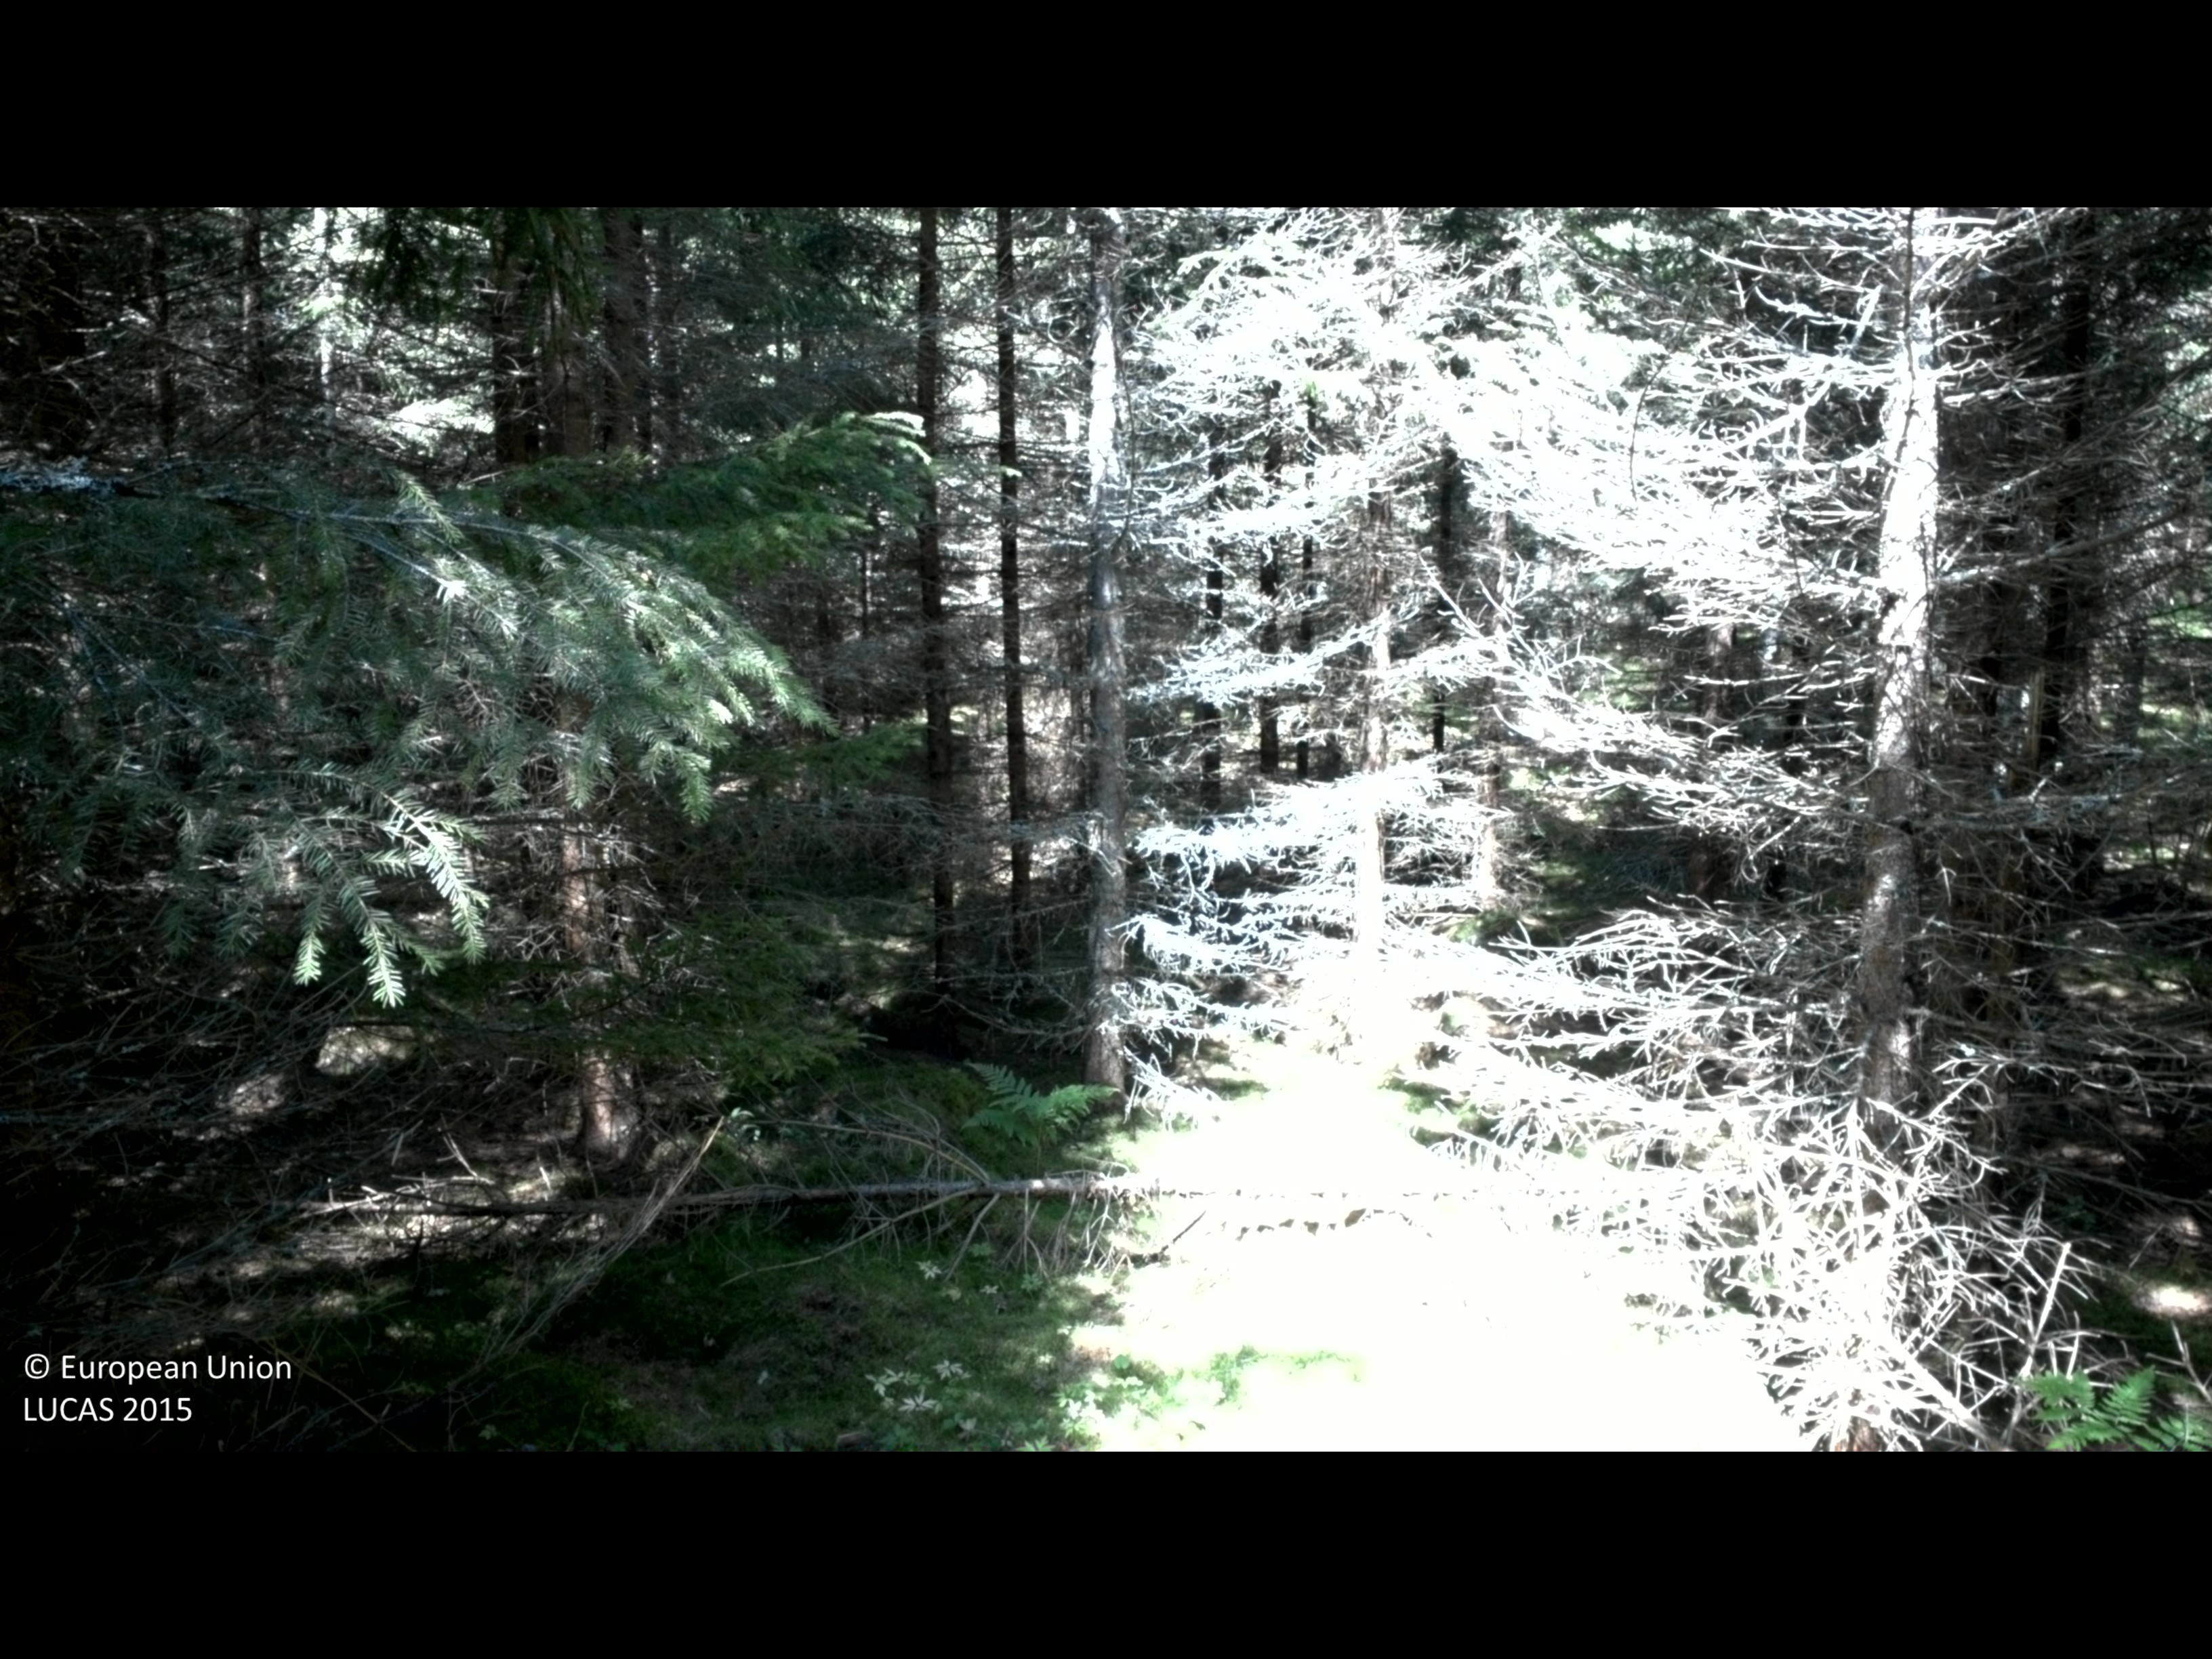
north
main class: Woodland
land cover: Spruce dominated coniferous woodland
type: boreal forest
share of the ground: > 75 %
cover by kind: coniferous forest trees 90 %, lichens and mosses 10 %
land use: Forestry
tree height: > 5 m
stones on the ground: > 50 %
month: June
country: SE
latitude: 58.1877
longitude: 16.1362
